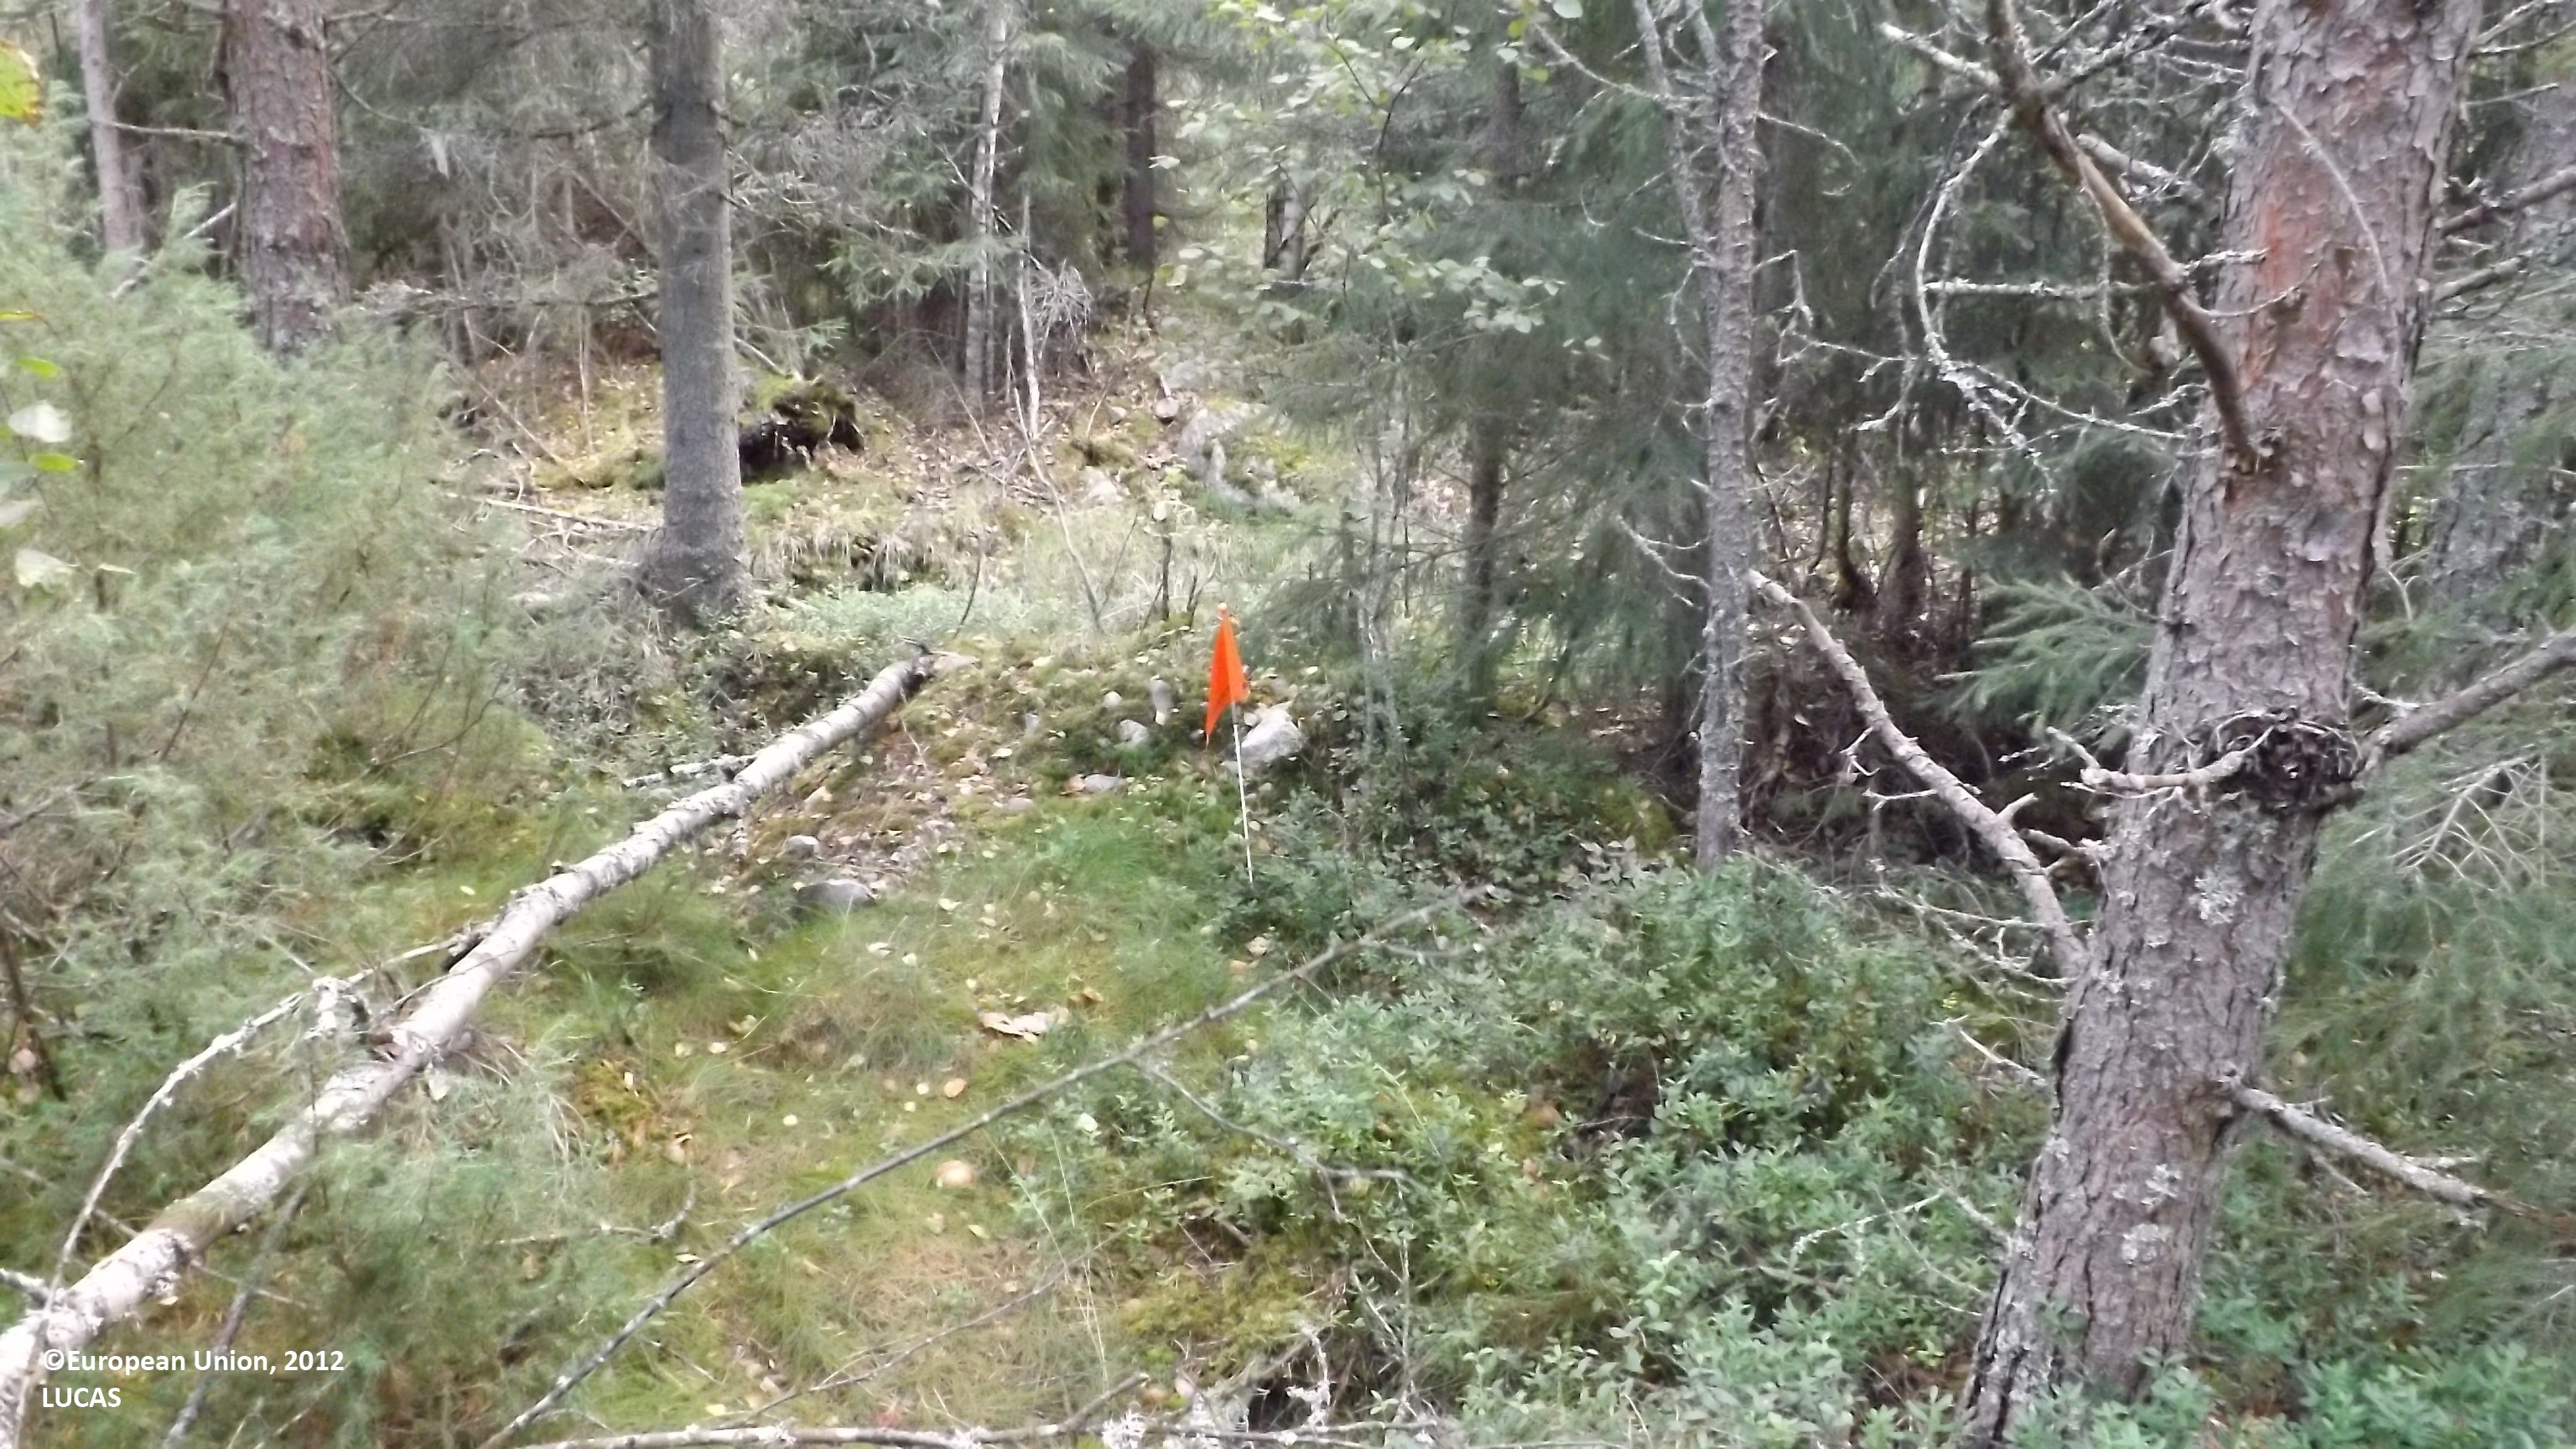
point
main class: Woodland
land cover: Other mixed woodland
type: boreal forest
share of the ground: > 75 %
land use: Forestry
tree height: > 5 m
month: August
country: FI
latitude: 63.7382
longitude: 23.9841
